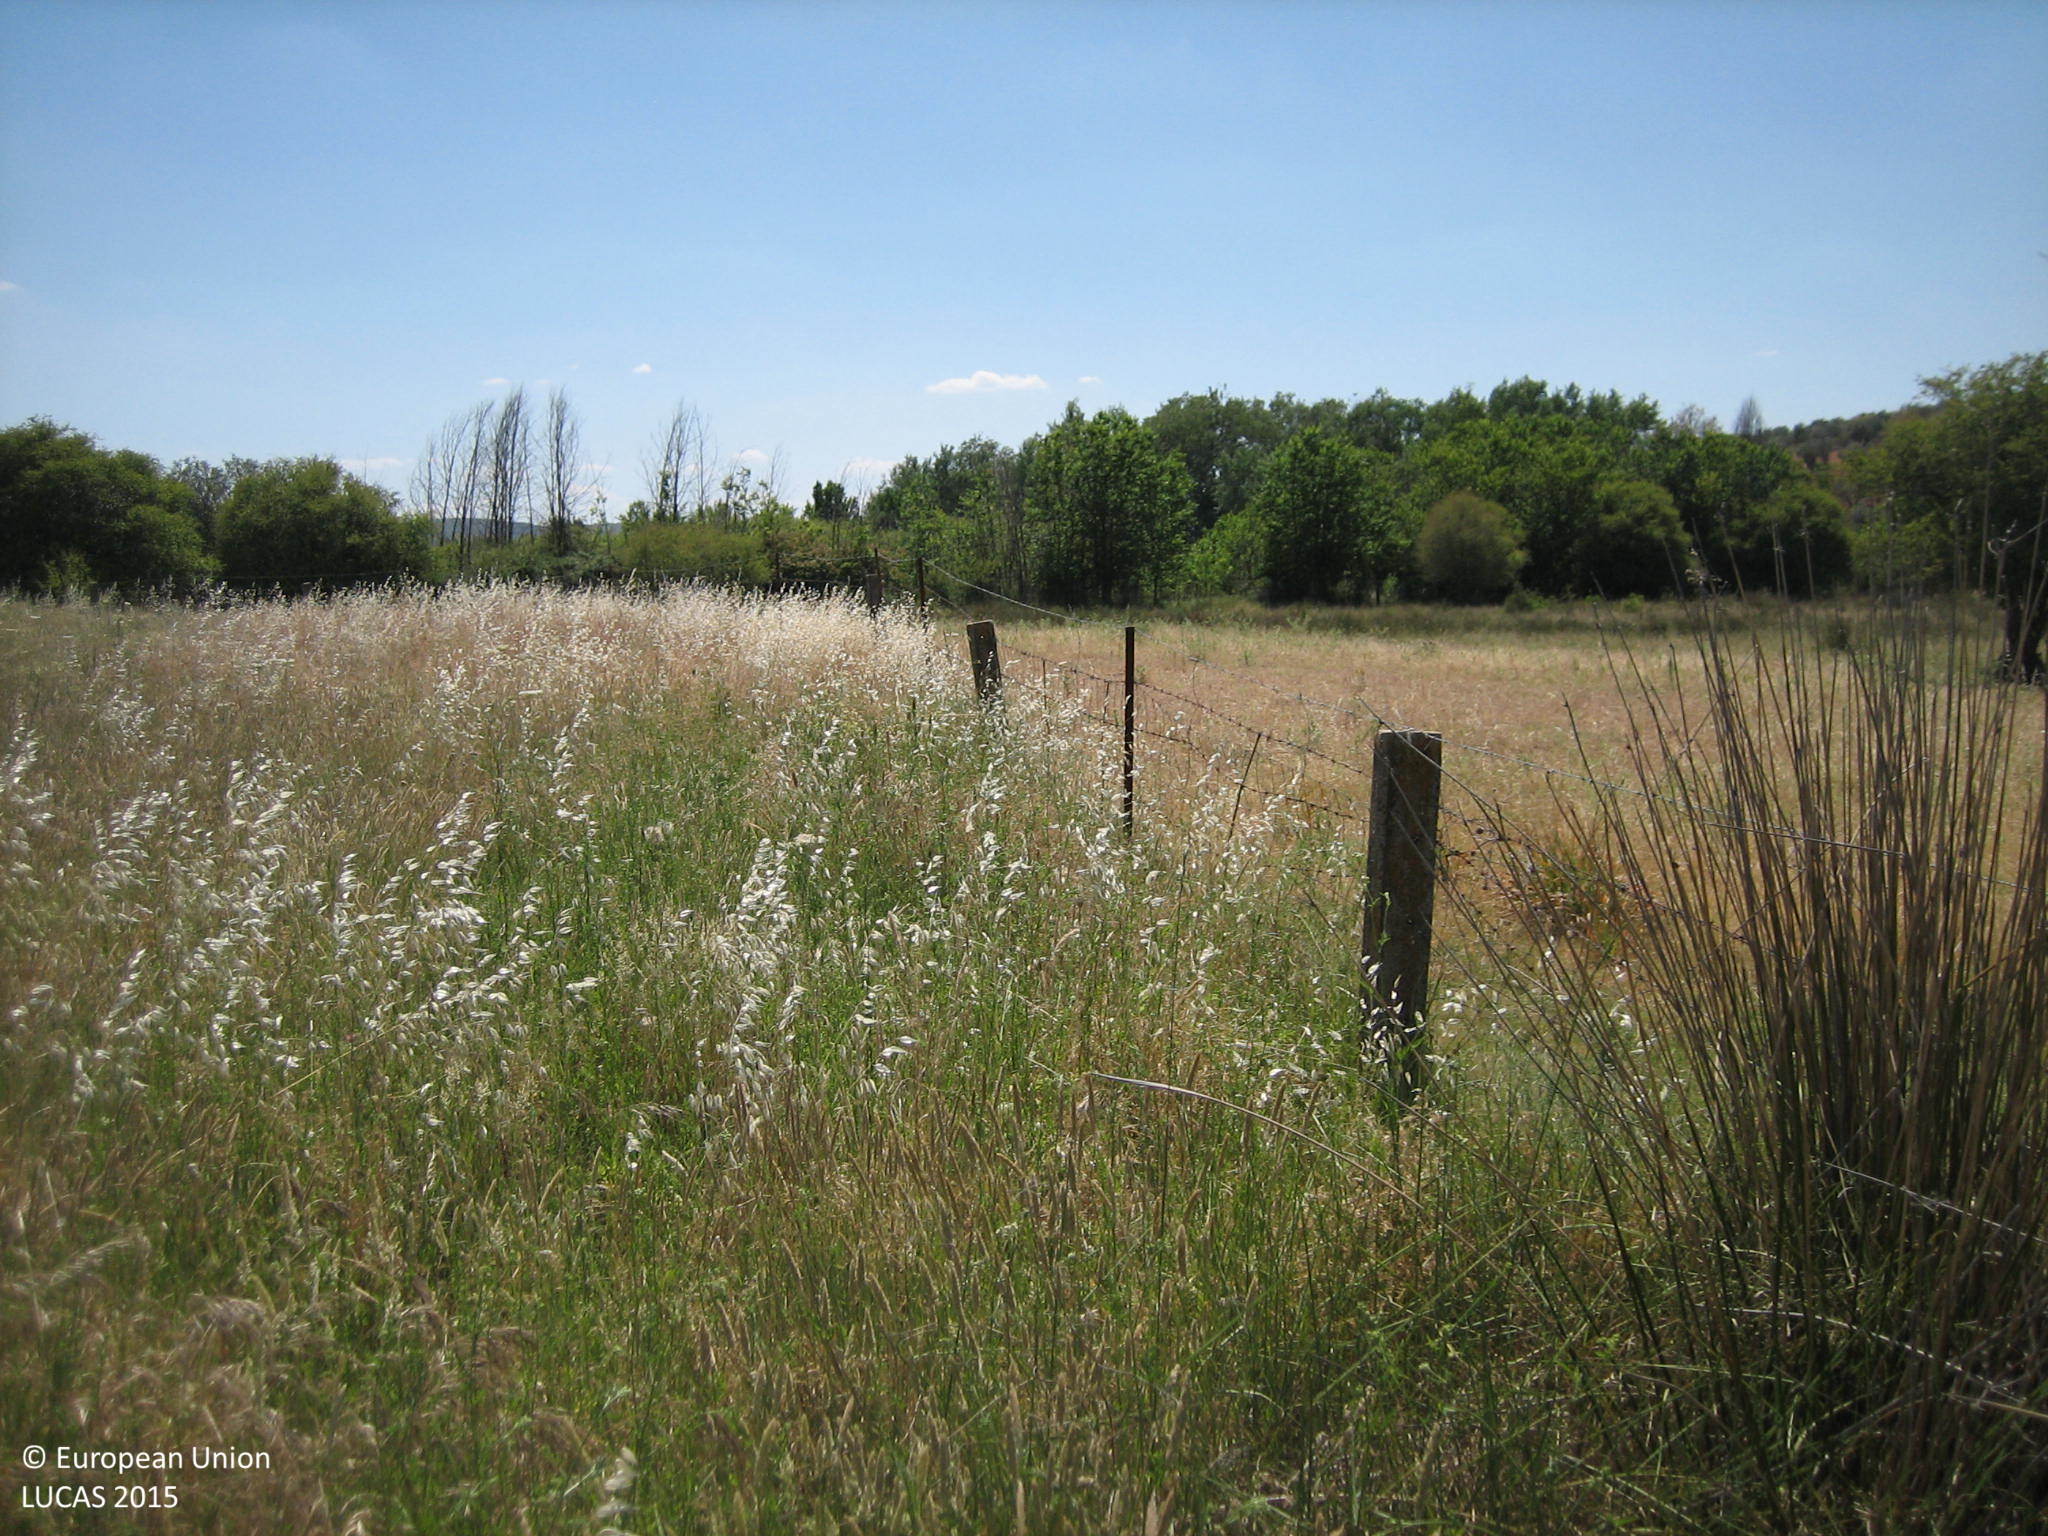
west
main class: Grassland
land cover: Grassland without tree/shrub cover
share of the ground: > 75 %
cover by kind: herbaceous plants 100 %
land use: Semi-natural and natural areas not in use
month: June
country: ES
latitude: 38.8739
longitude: -4.1179
